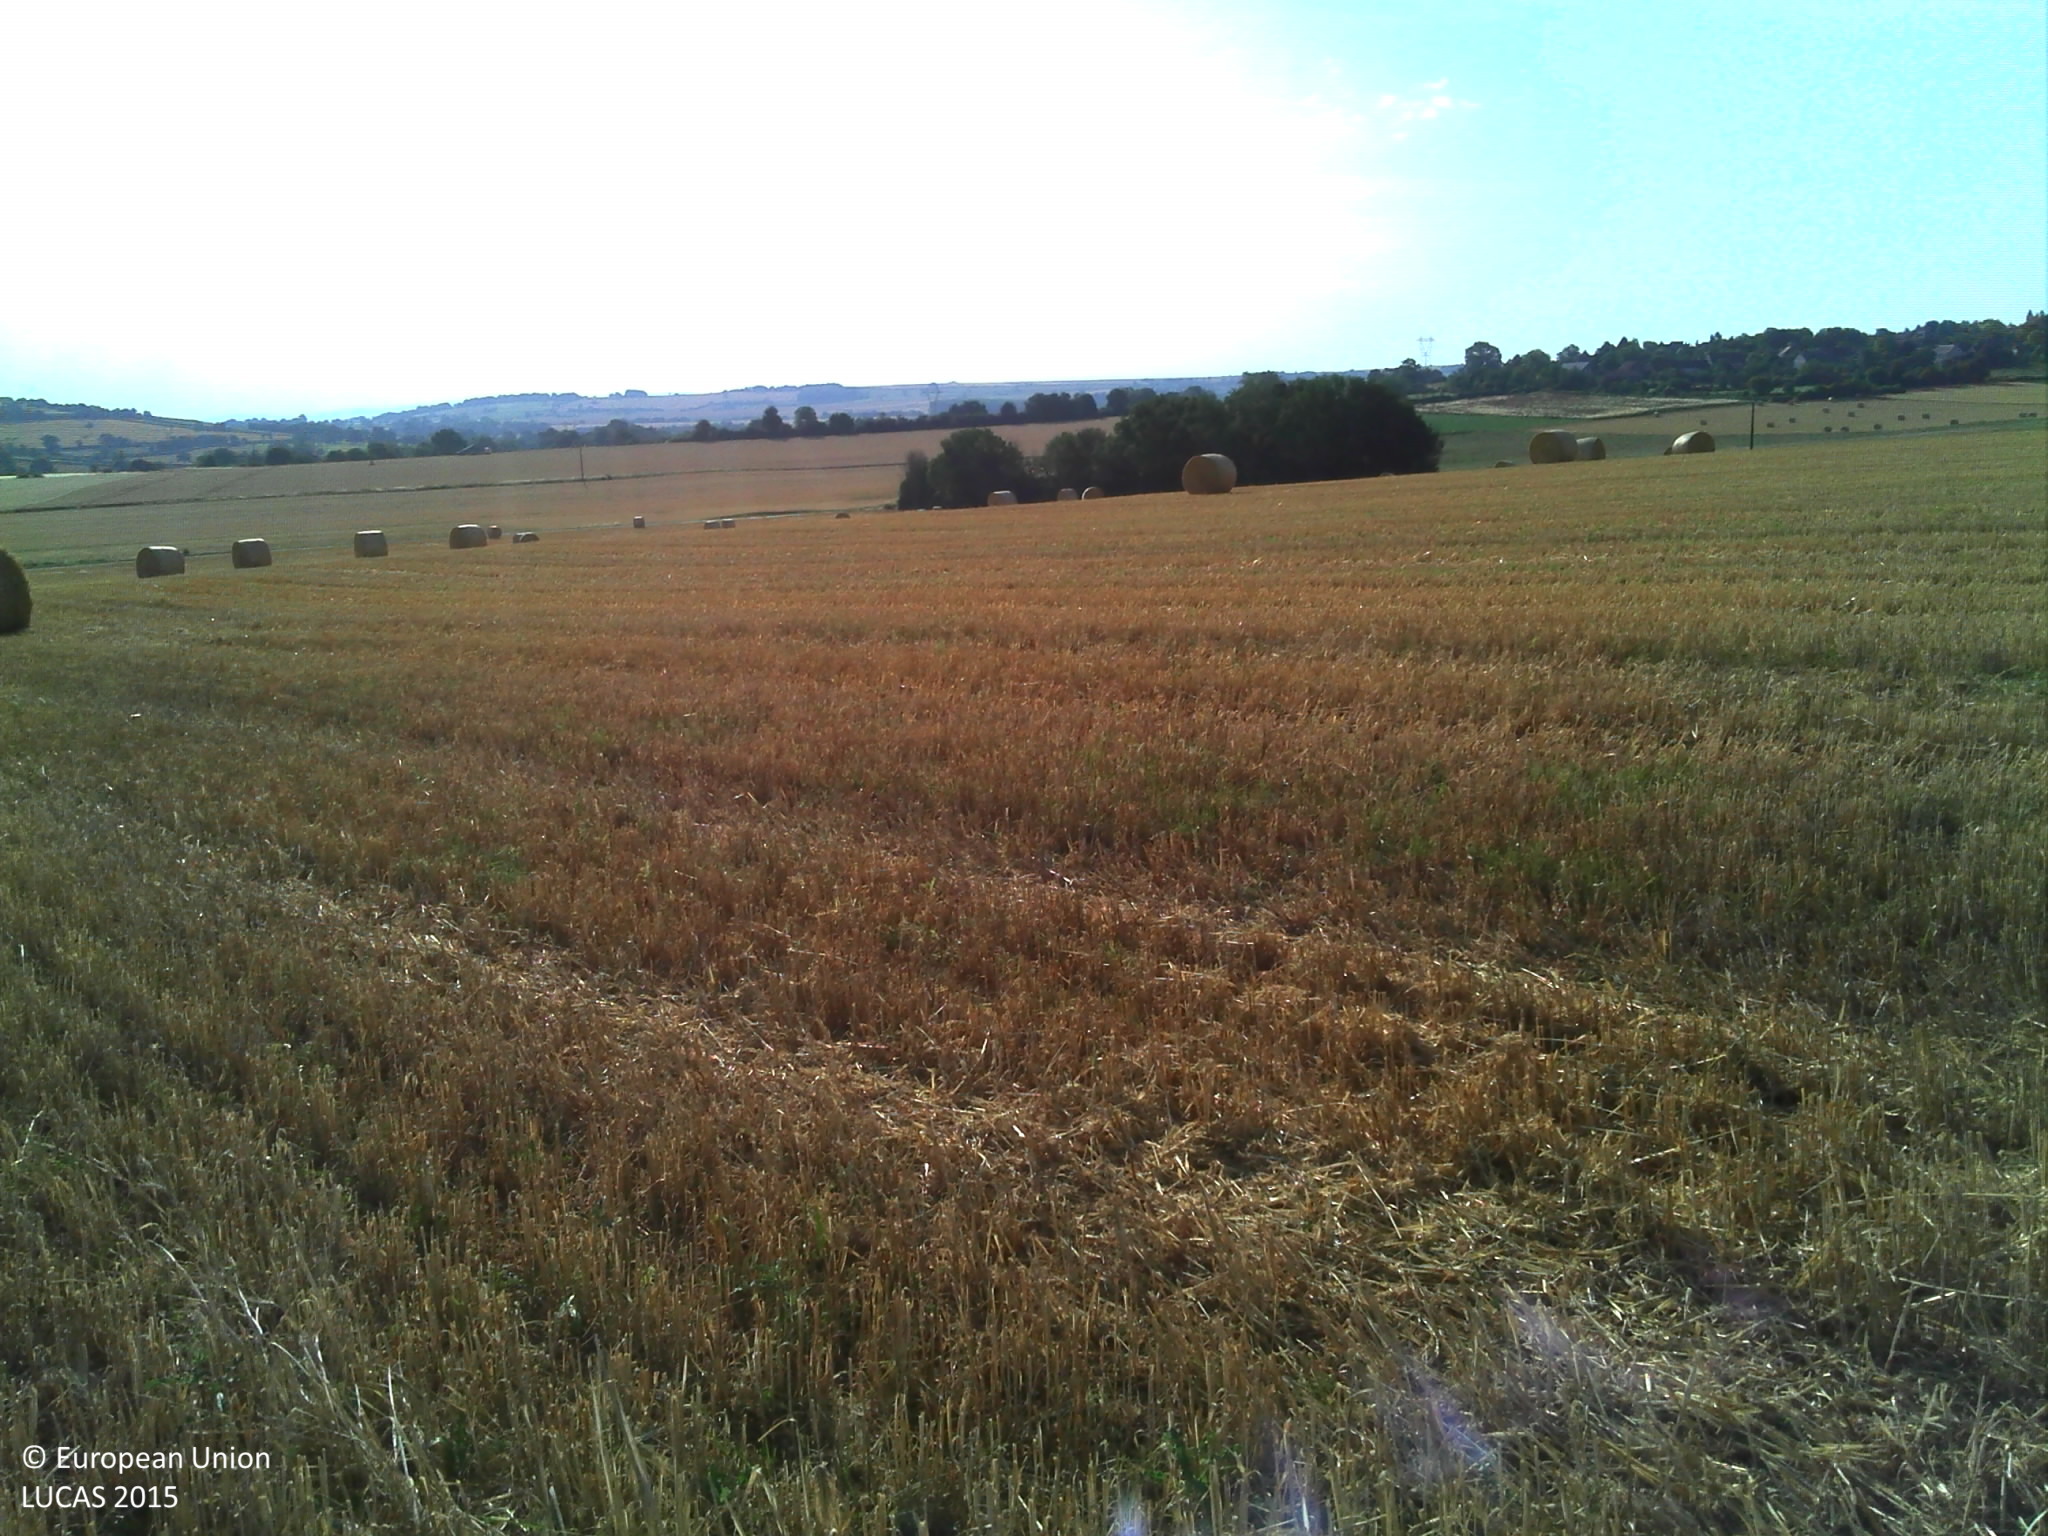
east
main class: Cropland
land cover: Barley
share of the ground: > 75 %
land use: Agriculture (excluding fallow land and kitchen gardens)
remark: Harvested field
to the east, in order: Barley
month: July
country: FR
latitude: 47.2737
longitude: 3.5064
